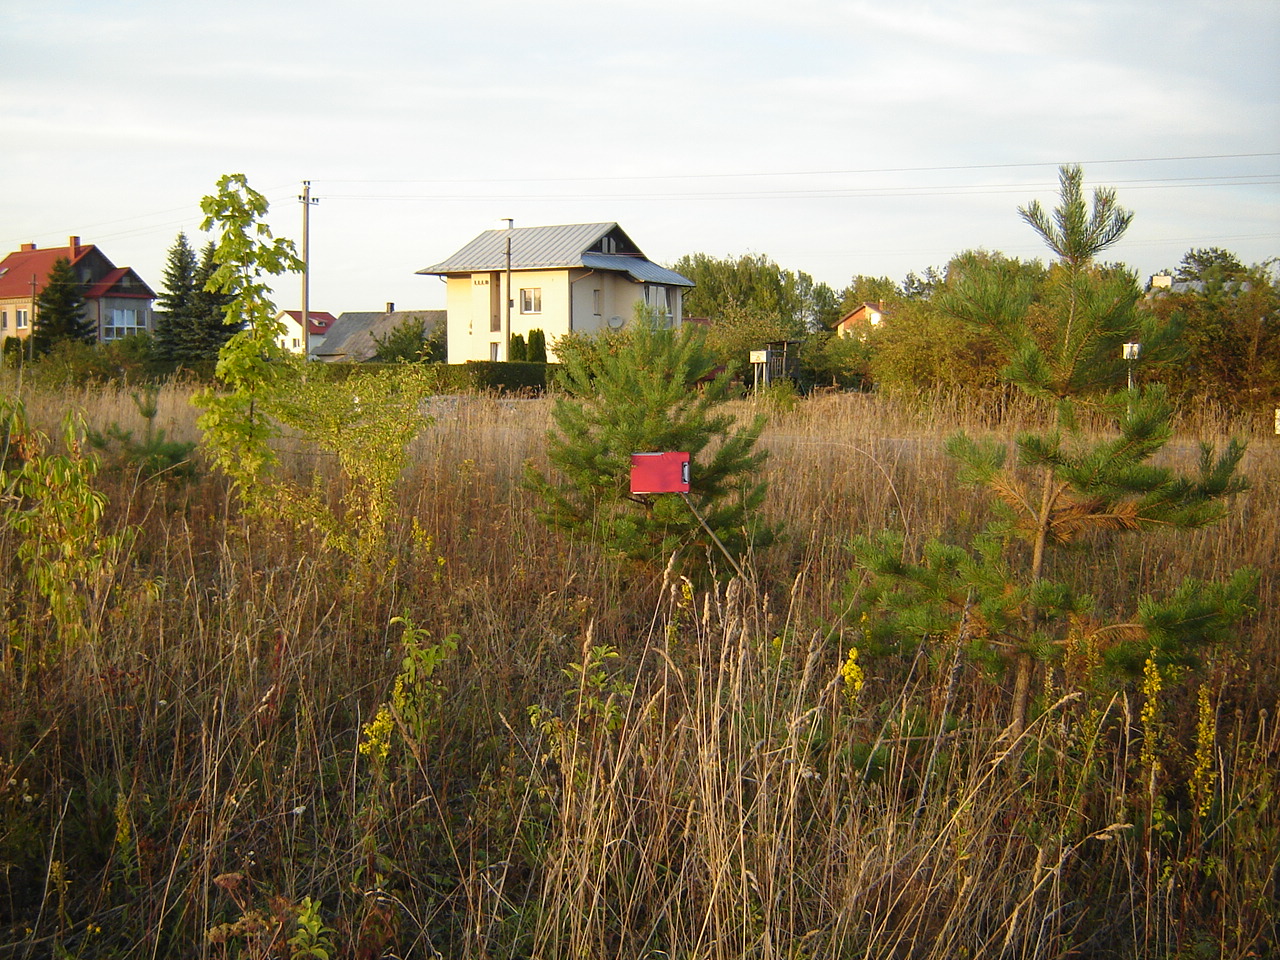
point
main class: Woodland
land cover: Pine dominated mixed woodland
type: hemiboreal forest and nemoral coniferous forest and mixed broadleaved-coniferous forest
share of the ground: 25 - 50 %
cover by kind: herbaceous plants 60 %, coniferous forest trees 25 %, broadleaved forest trees 15 %
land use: Forestry
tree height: < 5 m
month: August
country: LT
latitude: 54.5774
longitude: 25.2035
